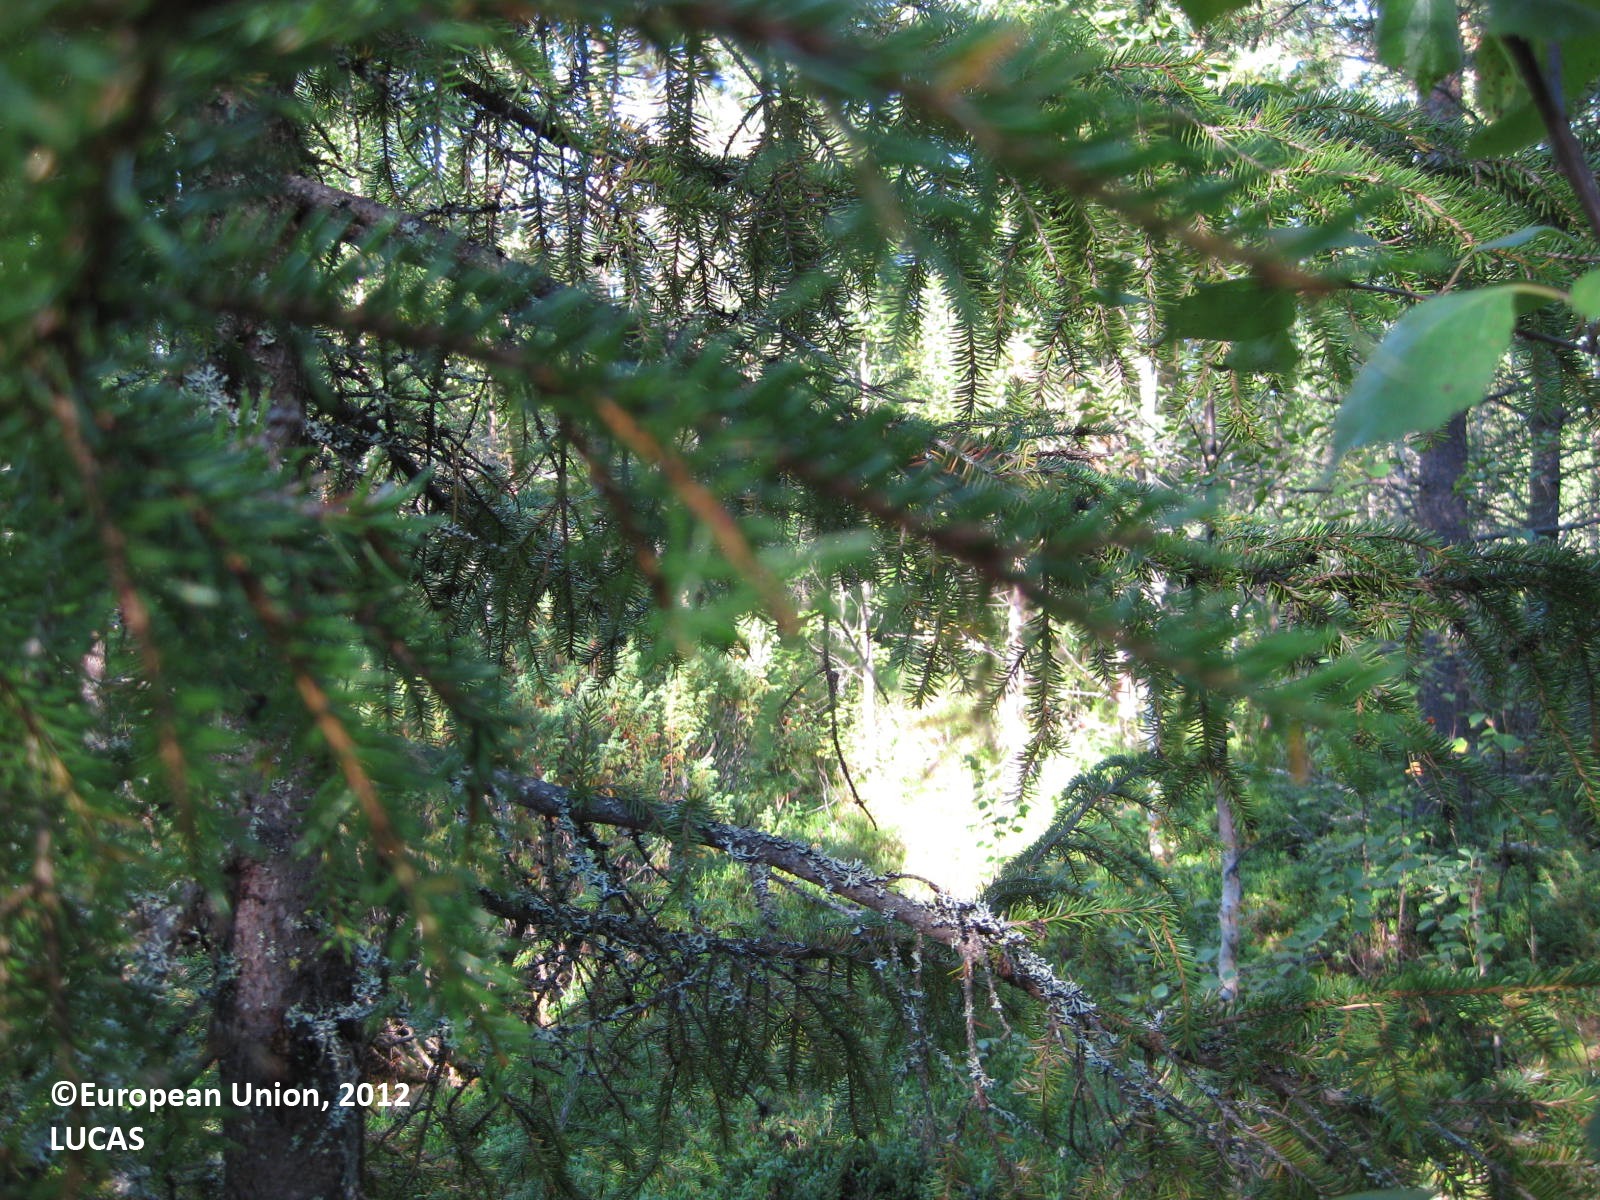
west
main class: Woodland
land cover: Pine dominated mixed woodland
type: boreal forest
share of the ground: > 75 %
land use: Forestry
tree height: > 5 m
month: August
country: FI
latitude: 66.6641
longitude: 29.1464
